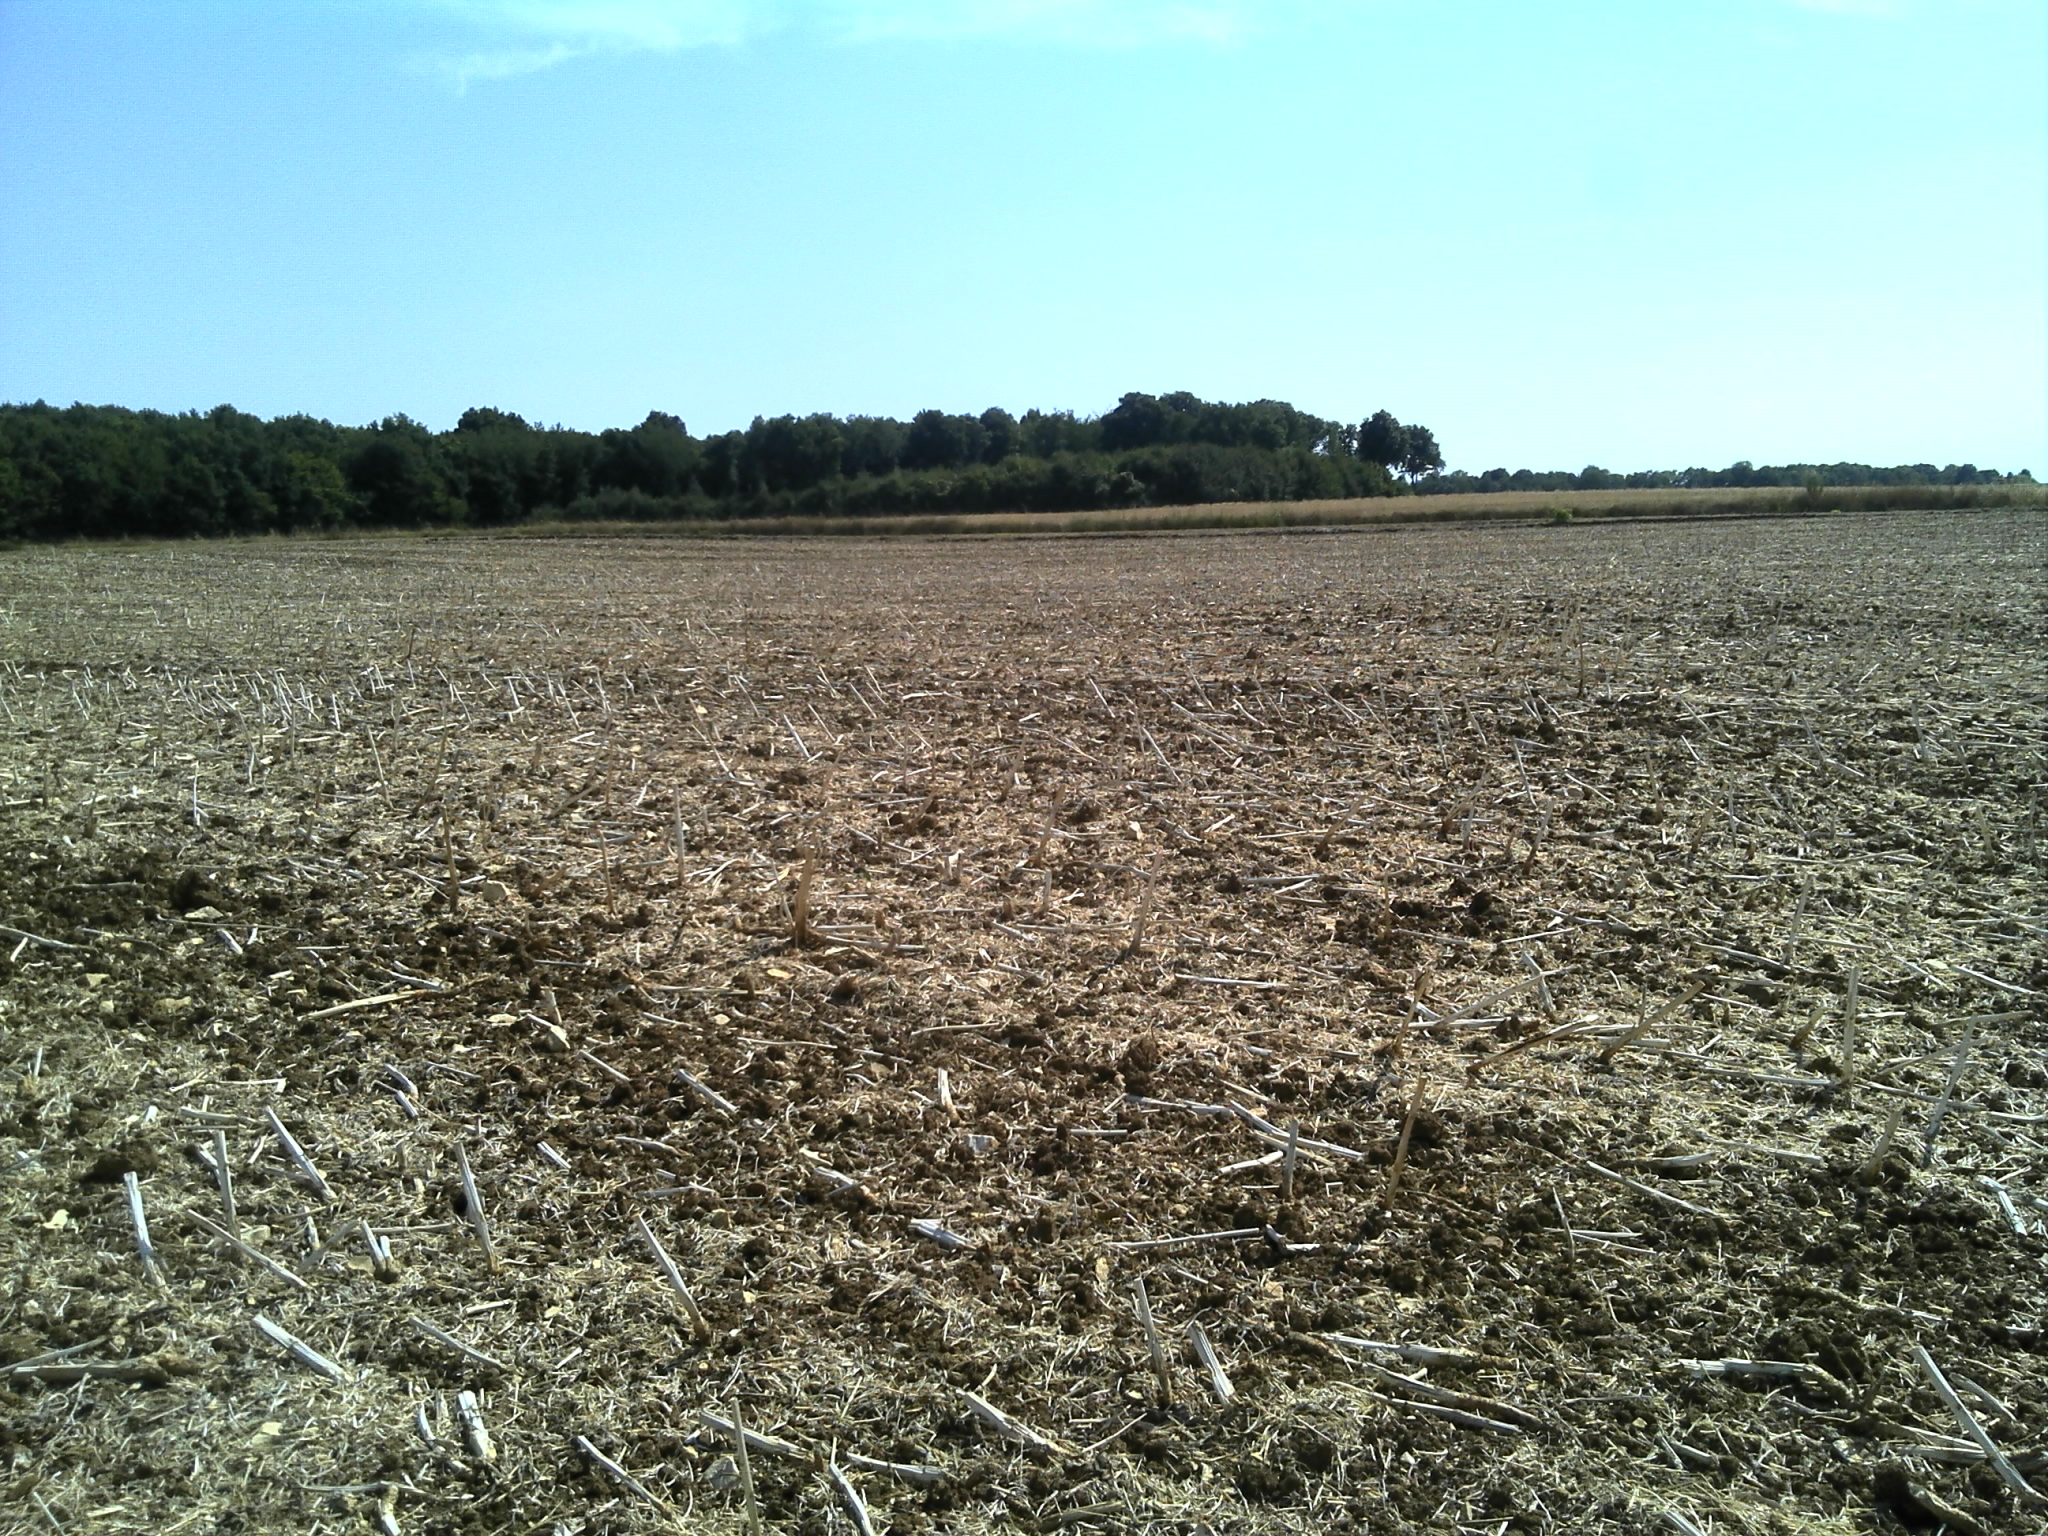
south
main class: Cropland
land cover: Rape and turnip rape
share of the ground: < 10 %
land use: Agriculture (excluding fallow land and kitchen gardens)
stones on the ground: < 10 %
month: August
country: FR
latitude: 46.9032
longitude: 1.5475
